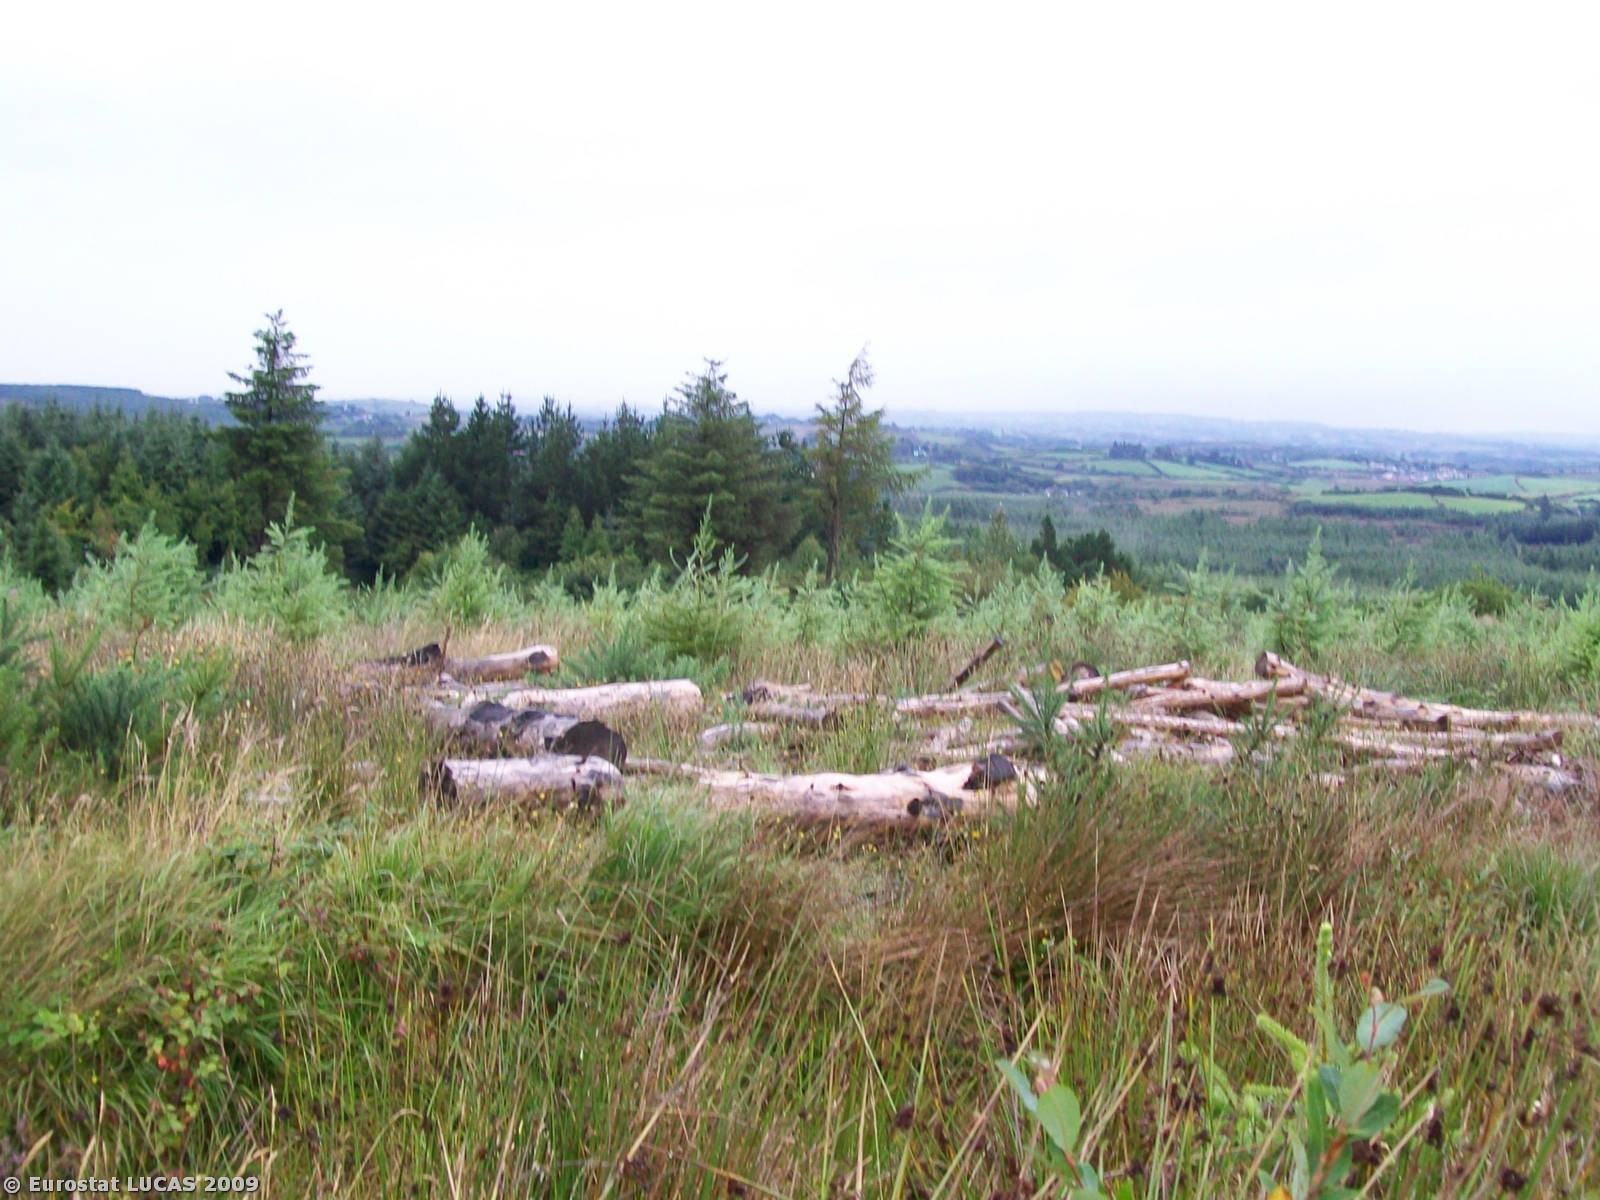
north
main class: Woodland
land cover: Coniferous woodland
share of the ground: > 75 %
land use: Forestry
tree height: < 5 m
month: August
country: IE
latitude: 52.7993
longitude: -9.1286
